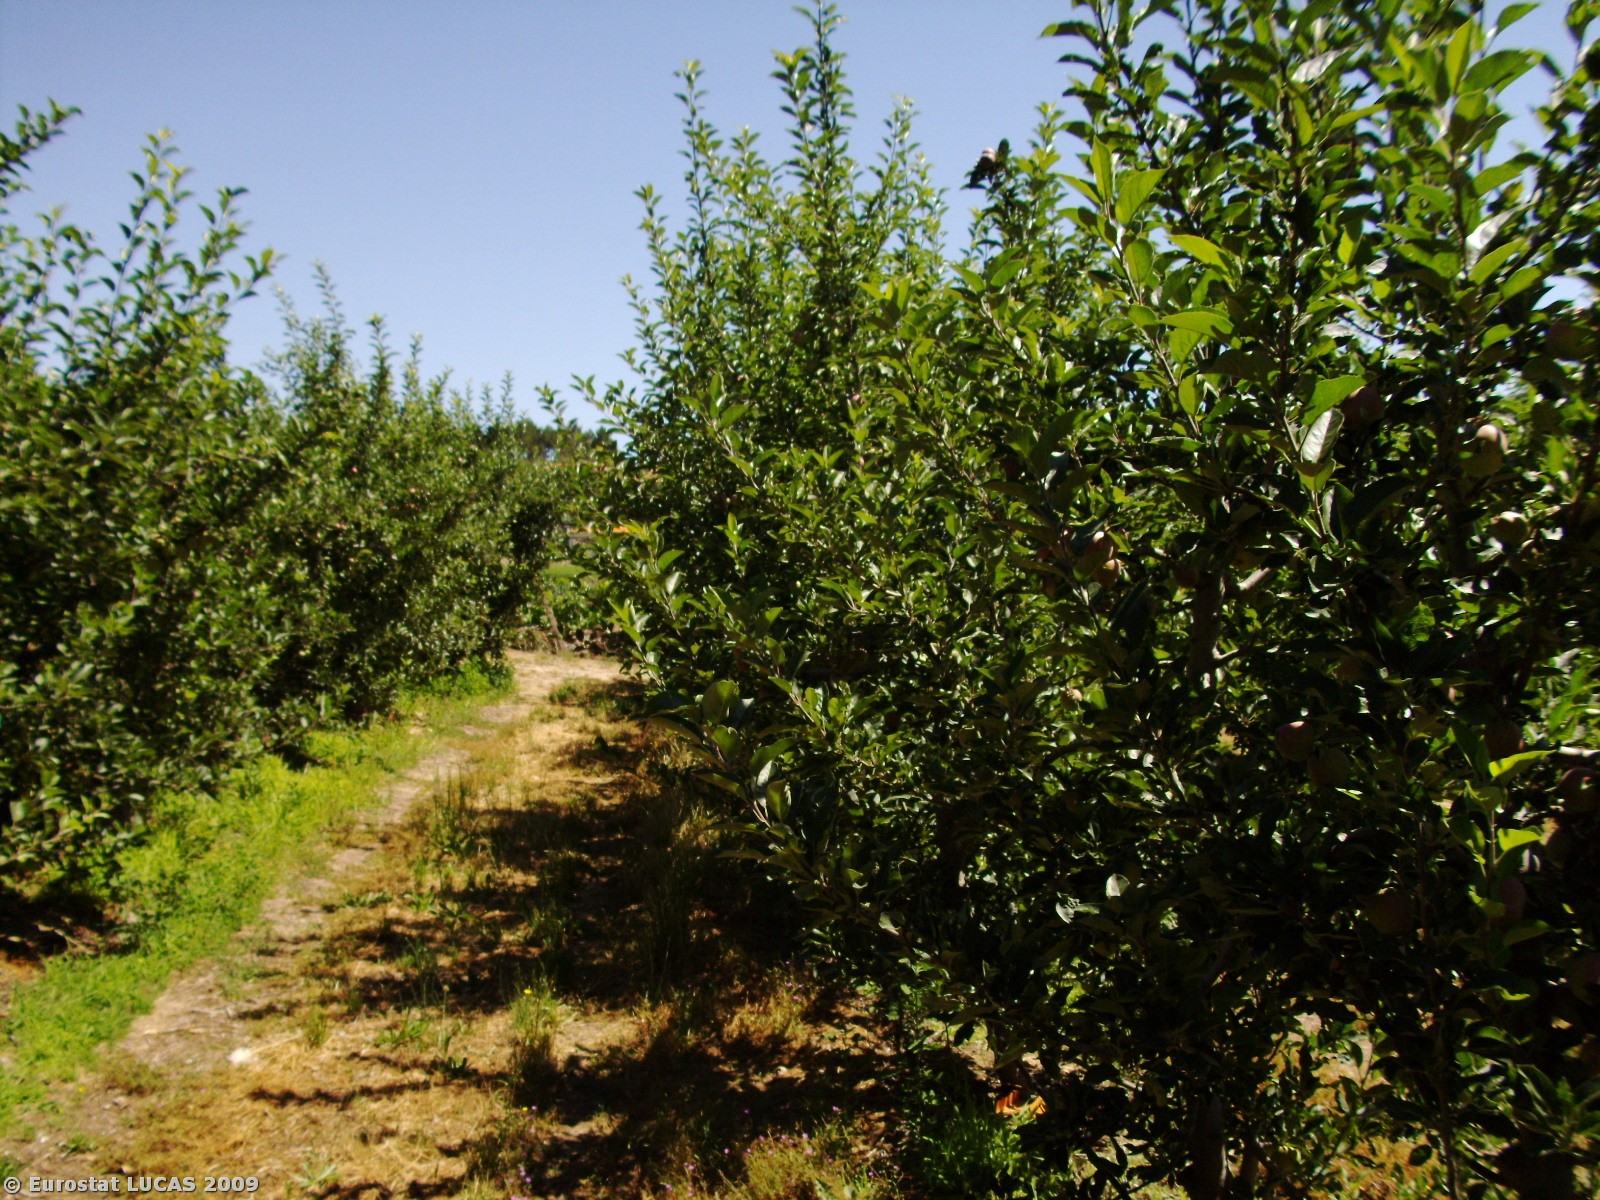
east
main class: Cropland
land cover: Apple fruit
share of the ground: > 75 %
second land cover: Spontaneously vegetated surfaces
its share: 10 - 25 %
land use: Agriculture (excluding fallow land and kitchen gardens)
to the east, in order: Apple fruit; Spontaneously vegetated surfaces; Apple fruit; Spontaneously vegetated surfaces; Tracks; Dry stone walls; Bare land; Dry stone walls; Spontaneously vegetated surfaces; Dry stone walls; Spontaneously vegetated surfaces; Dry stone walls; Apple fruit; Dry stone walls; Dry pulses; Dry stone walls; Bare land; Dry stone walls; Shrubland without tree cover; Dry stone walls; Paved roads, cycling and walking lanes; Artificial constructions in urban areas; Electric lines; Other fresh vegetables; Dry stone walls; Apple fruit; Dry stone walls; Spontaneously vegetated surfaces; Shrubland without tree cover; Dry stone walls; Shrubland without tree cover
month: July
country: PT
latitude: 41.0007
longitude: -7.7324
